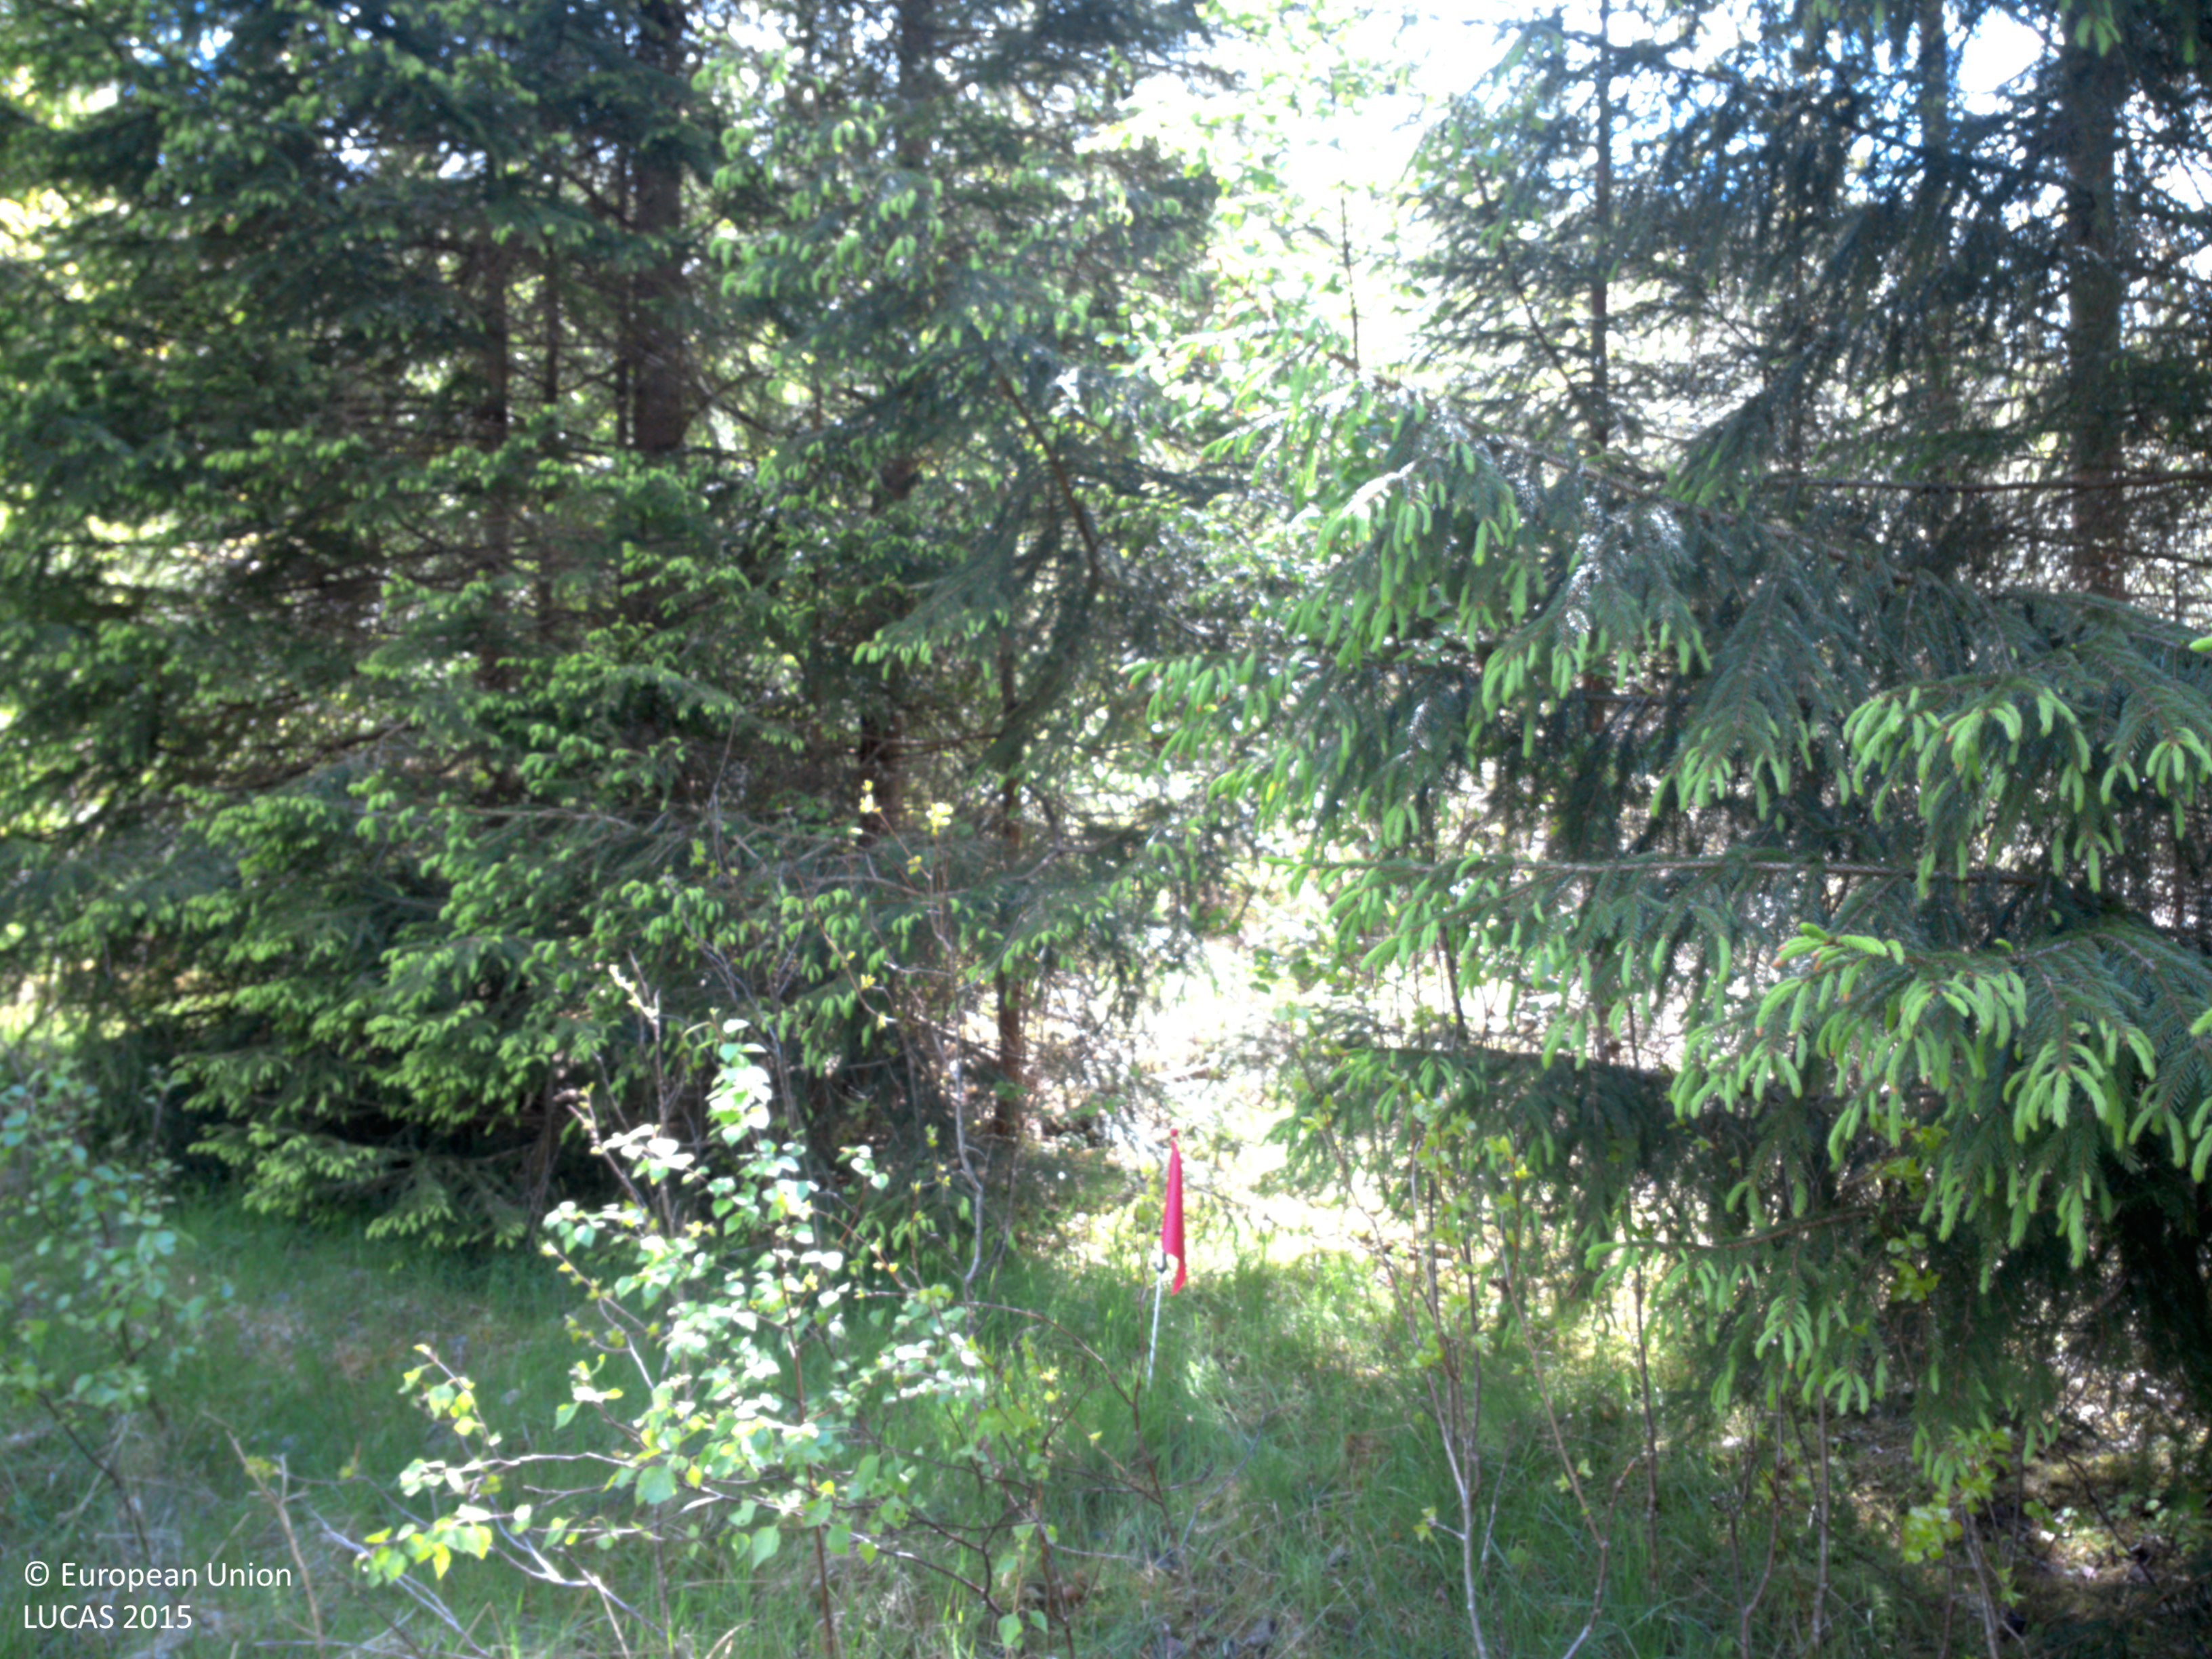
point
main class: Woodland
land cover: Spruce dominated mixed woodland
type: boreal forest
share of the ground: 25 - 50 %
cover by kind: herbaceous plants 50 %, coniferous forest trees 35 %, broadleaved forest trees 15 %
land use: Forestry
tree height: > 5 m
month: June
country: SE
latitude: 58.3137
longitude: 11.9250
